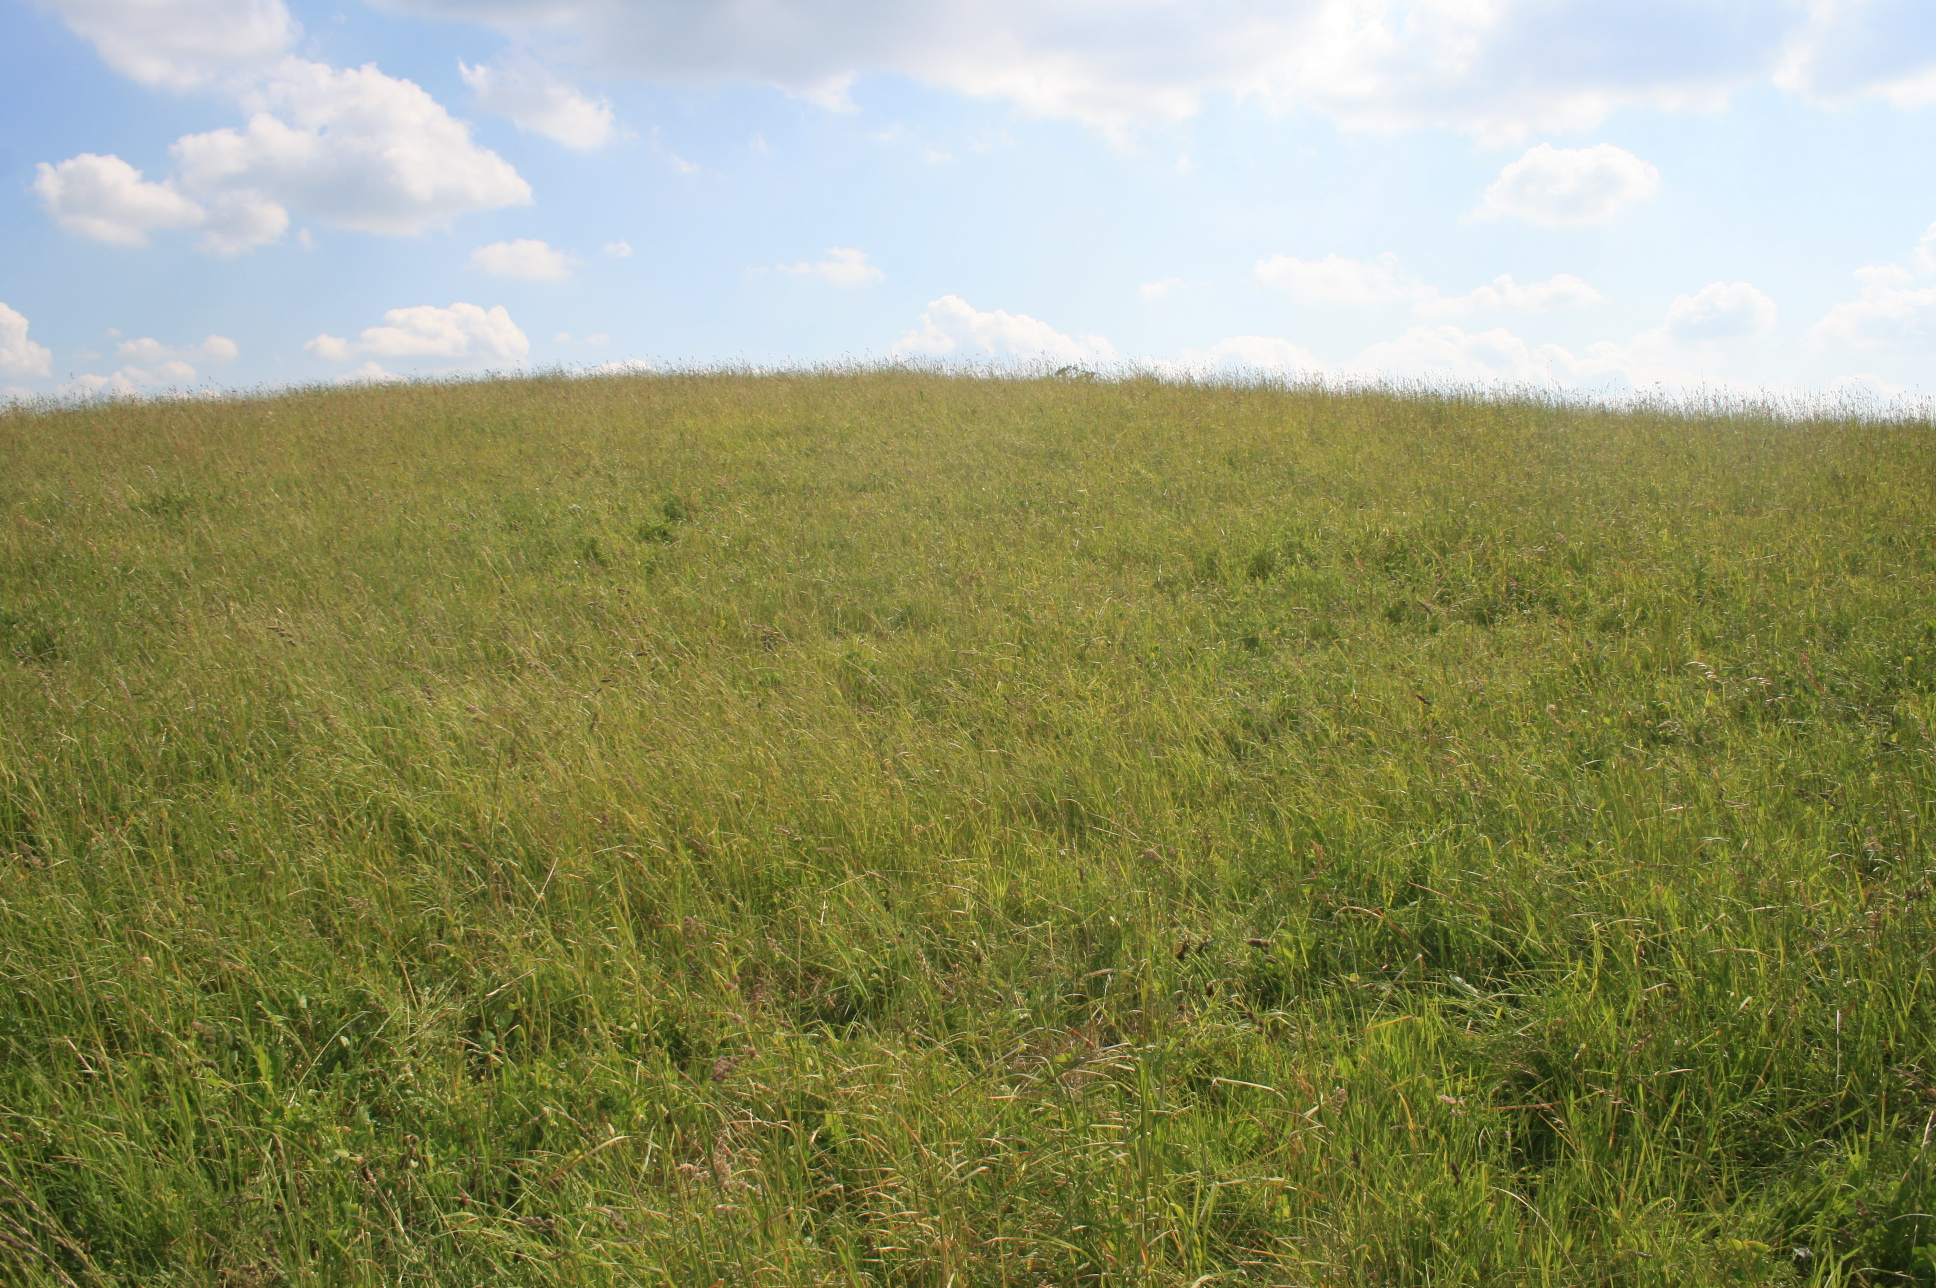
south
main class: Grassland
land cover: Grassland without tree/shrub cover
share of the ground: > 75 %
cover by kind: herbaceous plants 100 %
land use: Agriculture (excluding fallow land and kitchen gardens)
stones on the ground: < 10 %
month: June
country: LT
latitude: 55.6239
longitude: 22.1722
